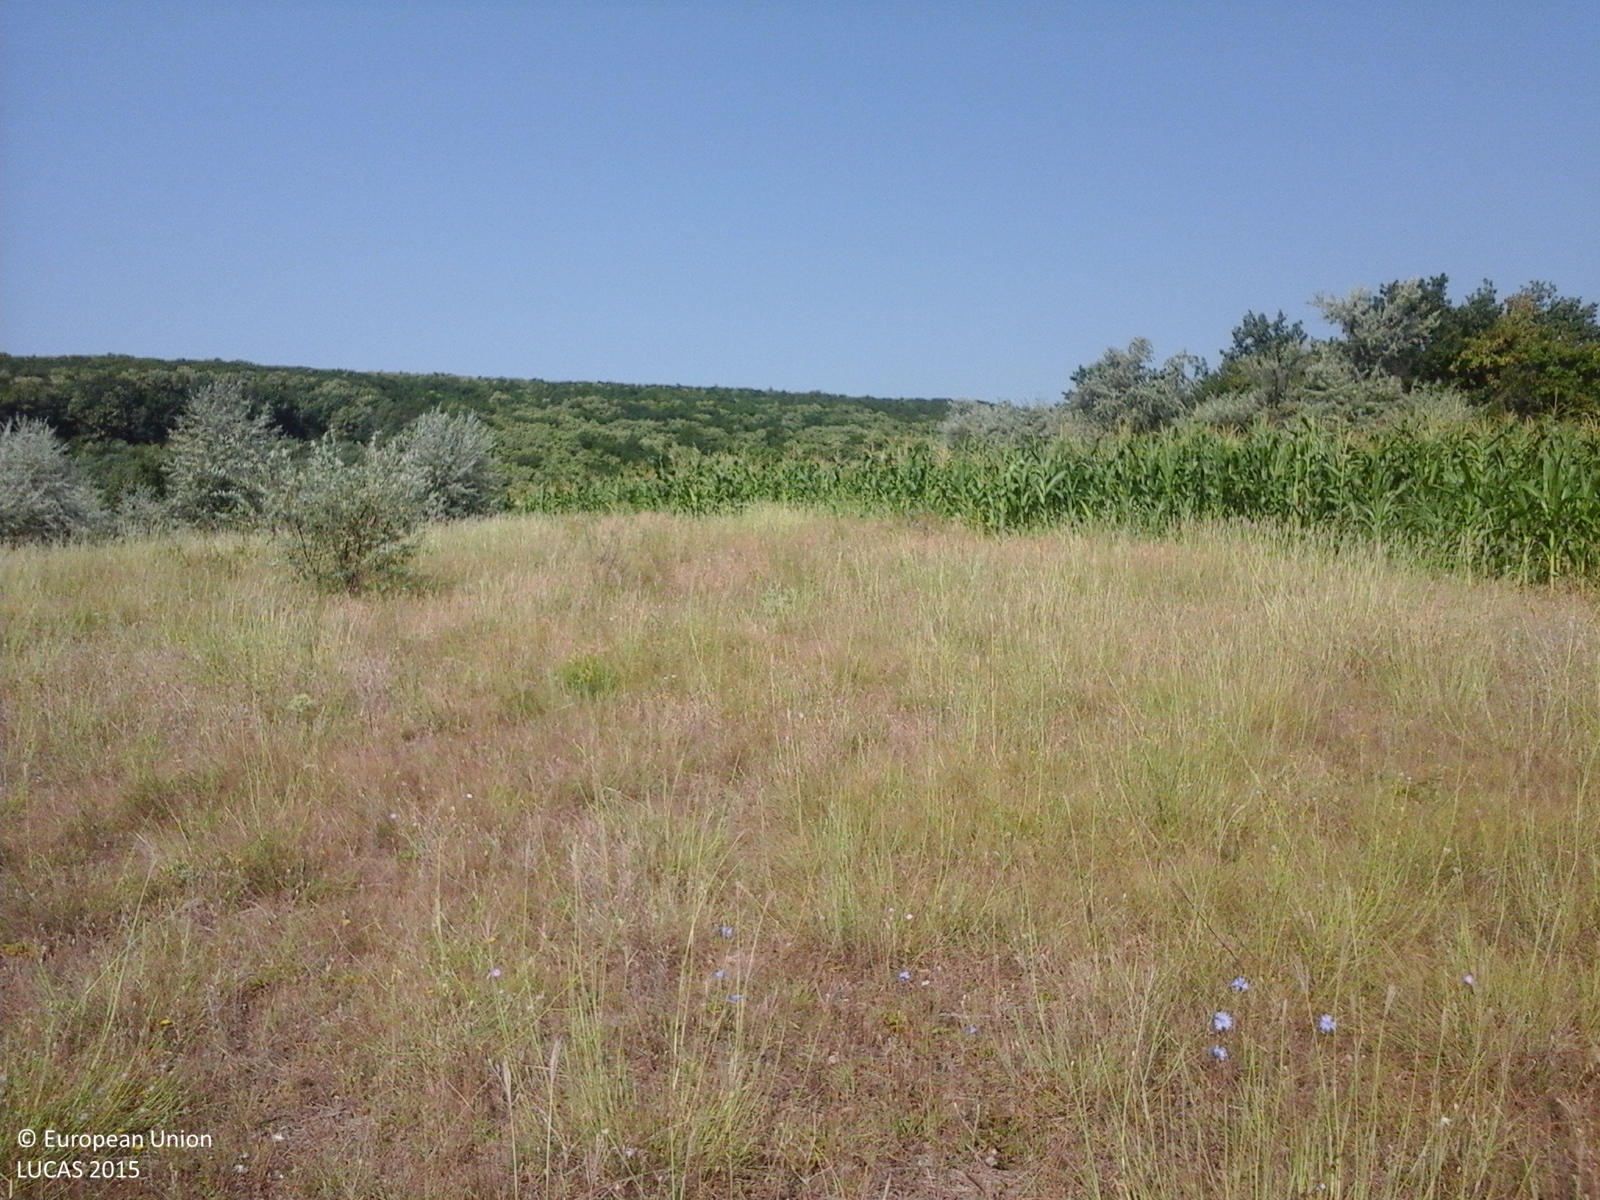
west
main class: Grassland
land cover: Grassland with sparse tree/shrub cover
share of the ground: > 75 %
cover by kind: herbaceous plants 95 %, broadleaved forest trees 5 %
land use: Agriculture (excluding fallow land and kitchen gardens)
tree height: > 5 m
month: July
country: RO
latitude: 46.0525
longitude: 27.8372
